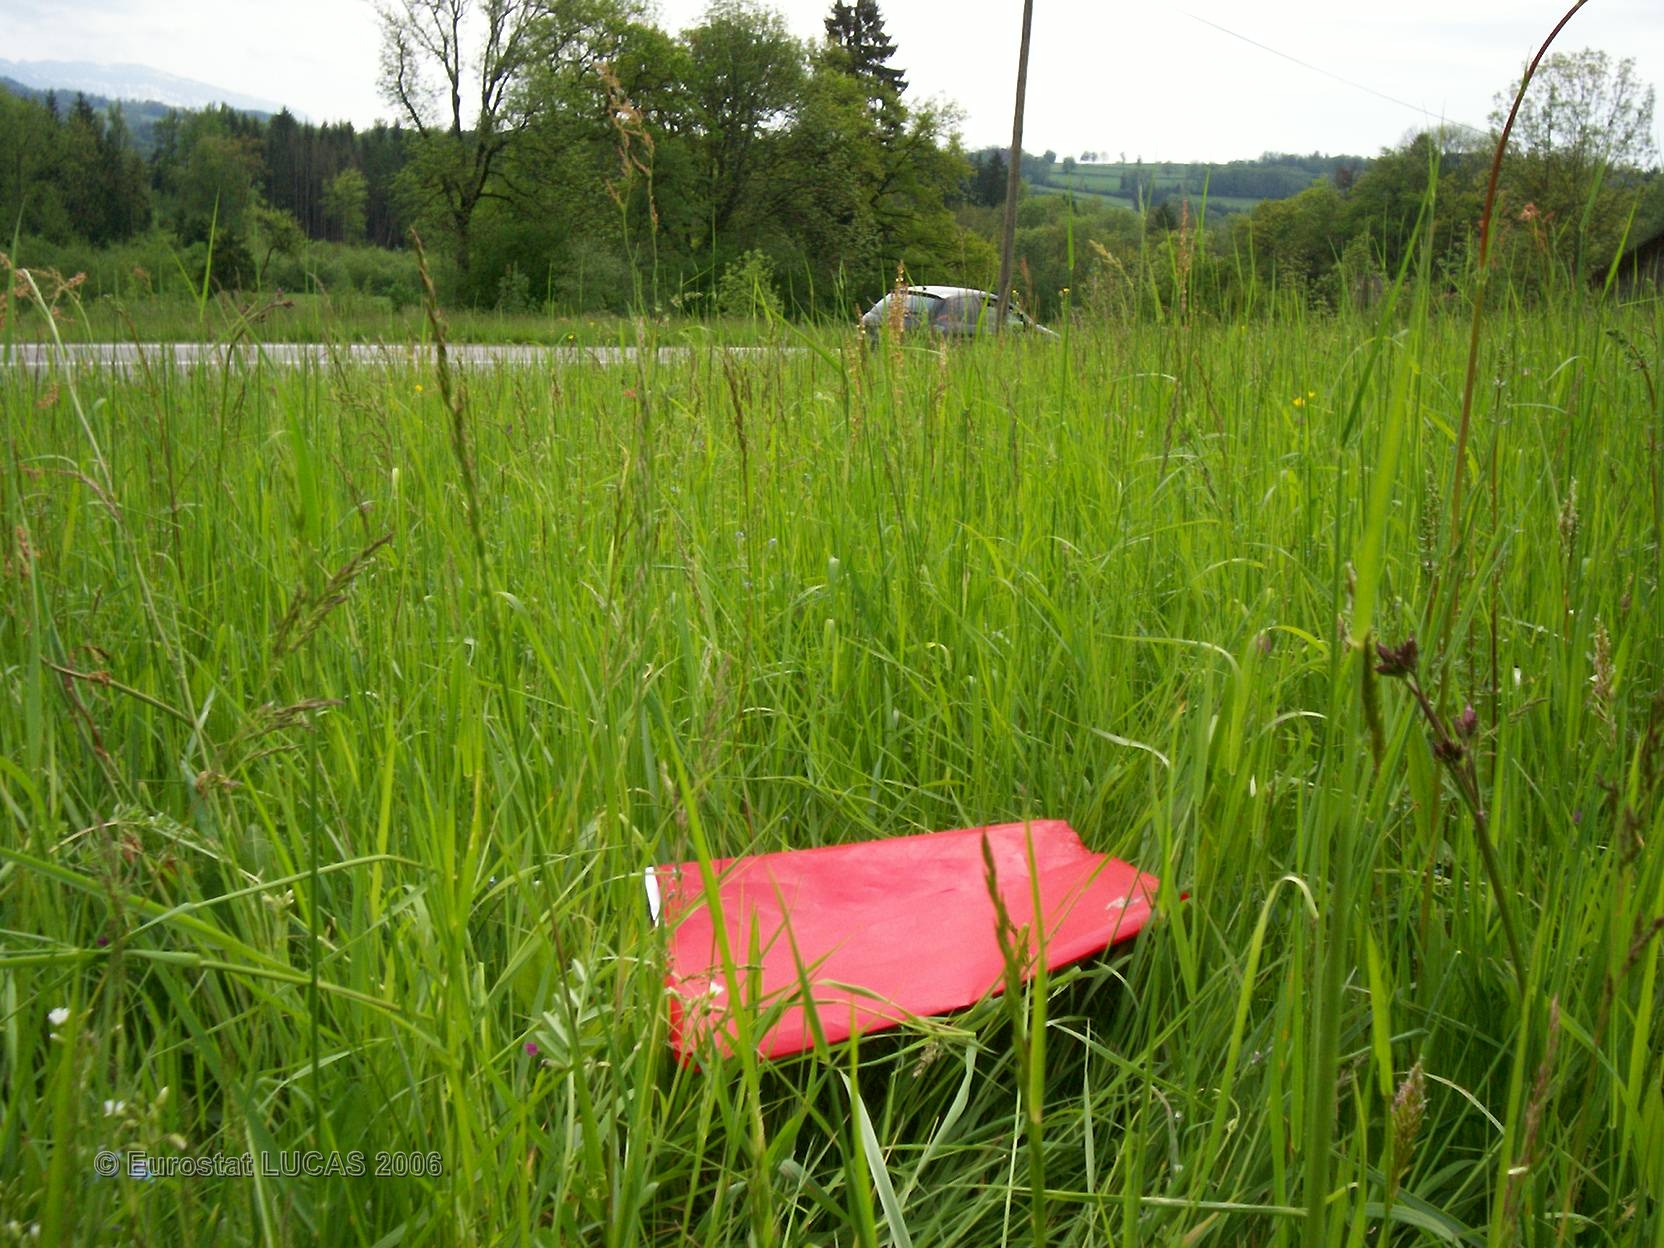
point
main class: Grassland
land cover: Grassland without tree/shrub cover
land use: Agriculture (excluding fallow land and kitchen gardens)
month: May
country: FR
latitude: 46.1461
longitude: 6.3915
